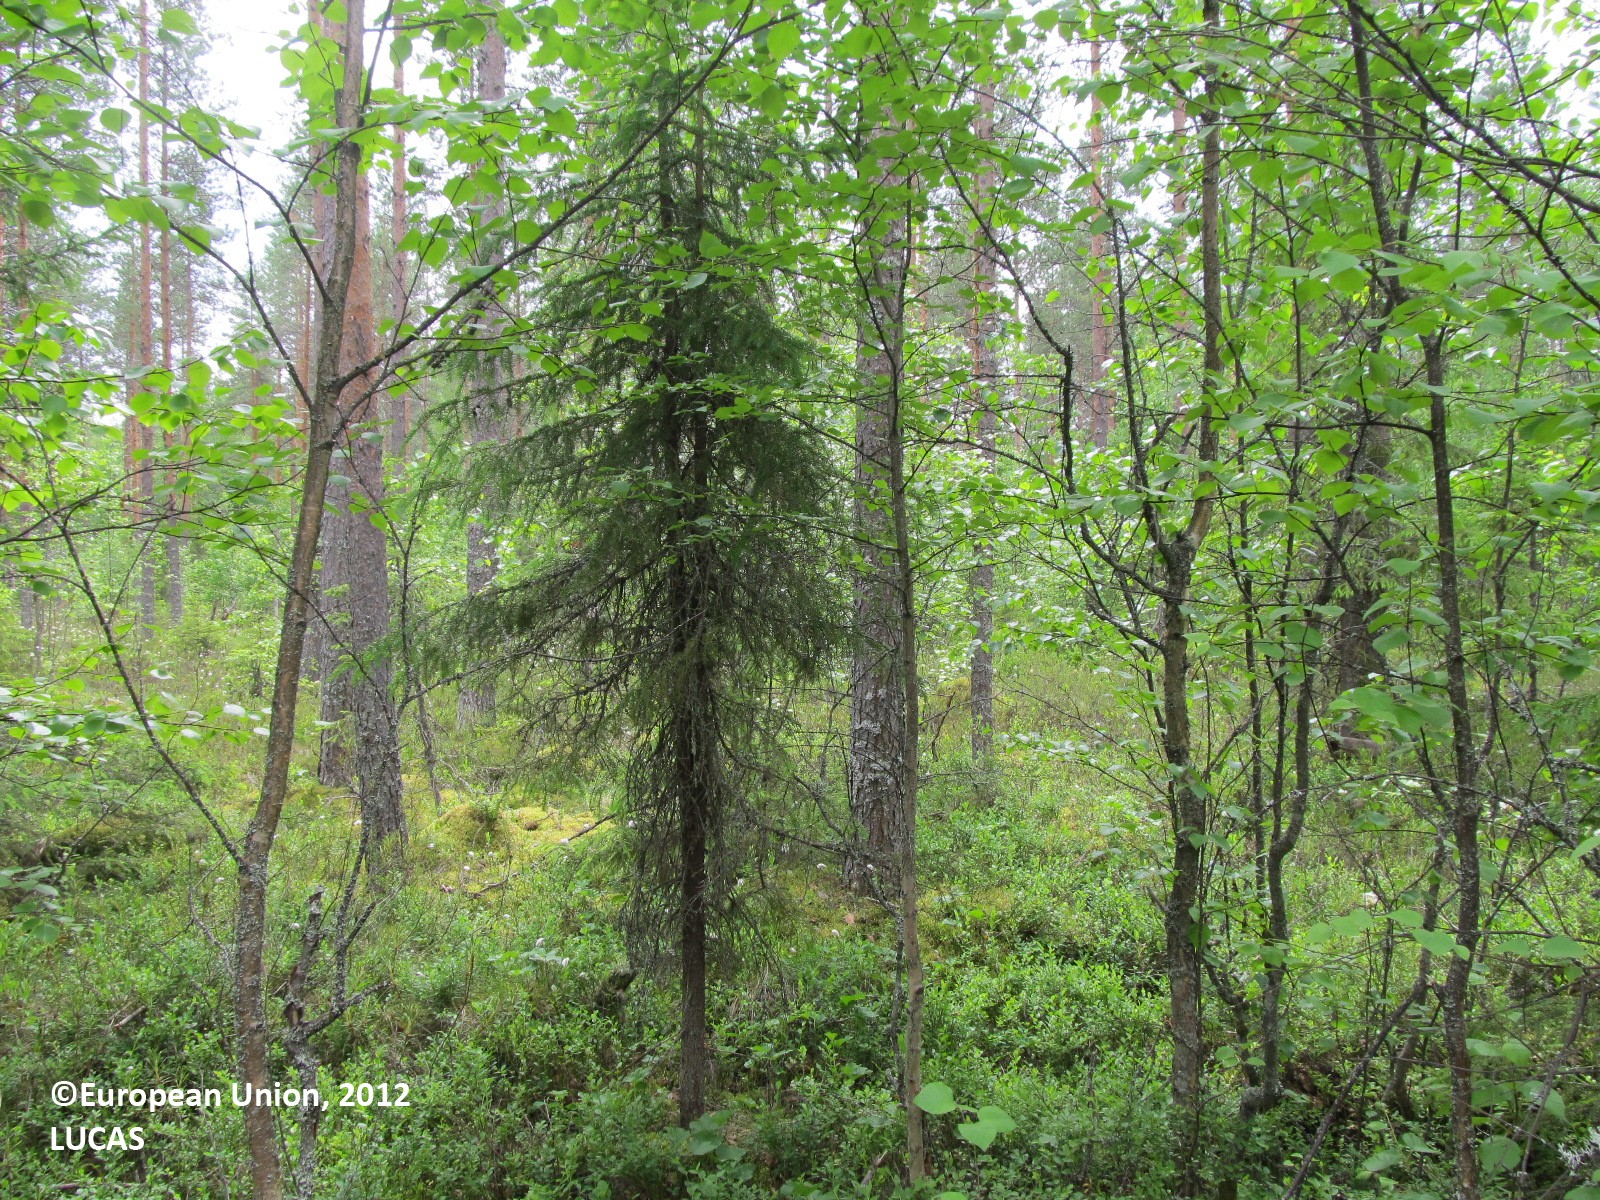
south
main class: Woodland
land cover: Pine dominated mixed woodland
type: boreal forest
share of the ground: 50 - 75 %
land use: Forestry
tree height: > 5 m
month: June
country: FI
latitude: 62.8211
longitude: 28.9958
